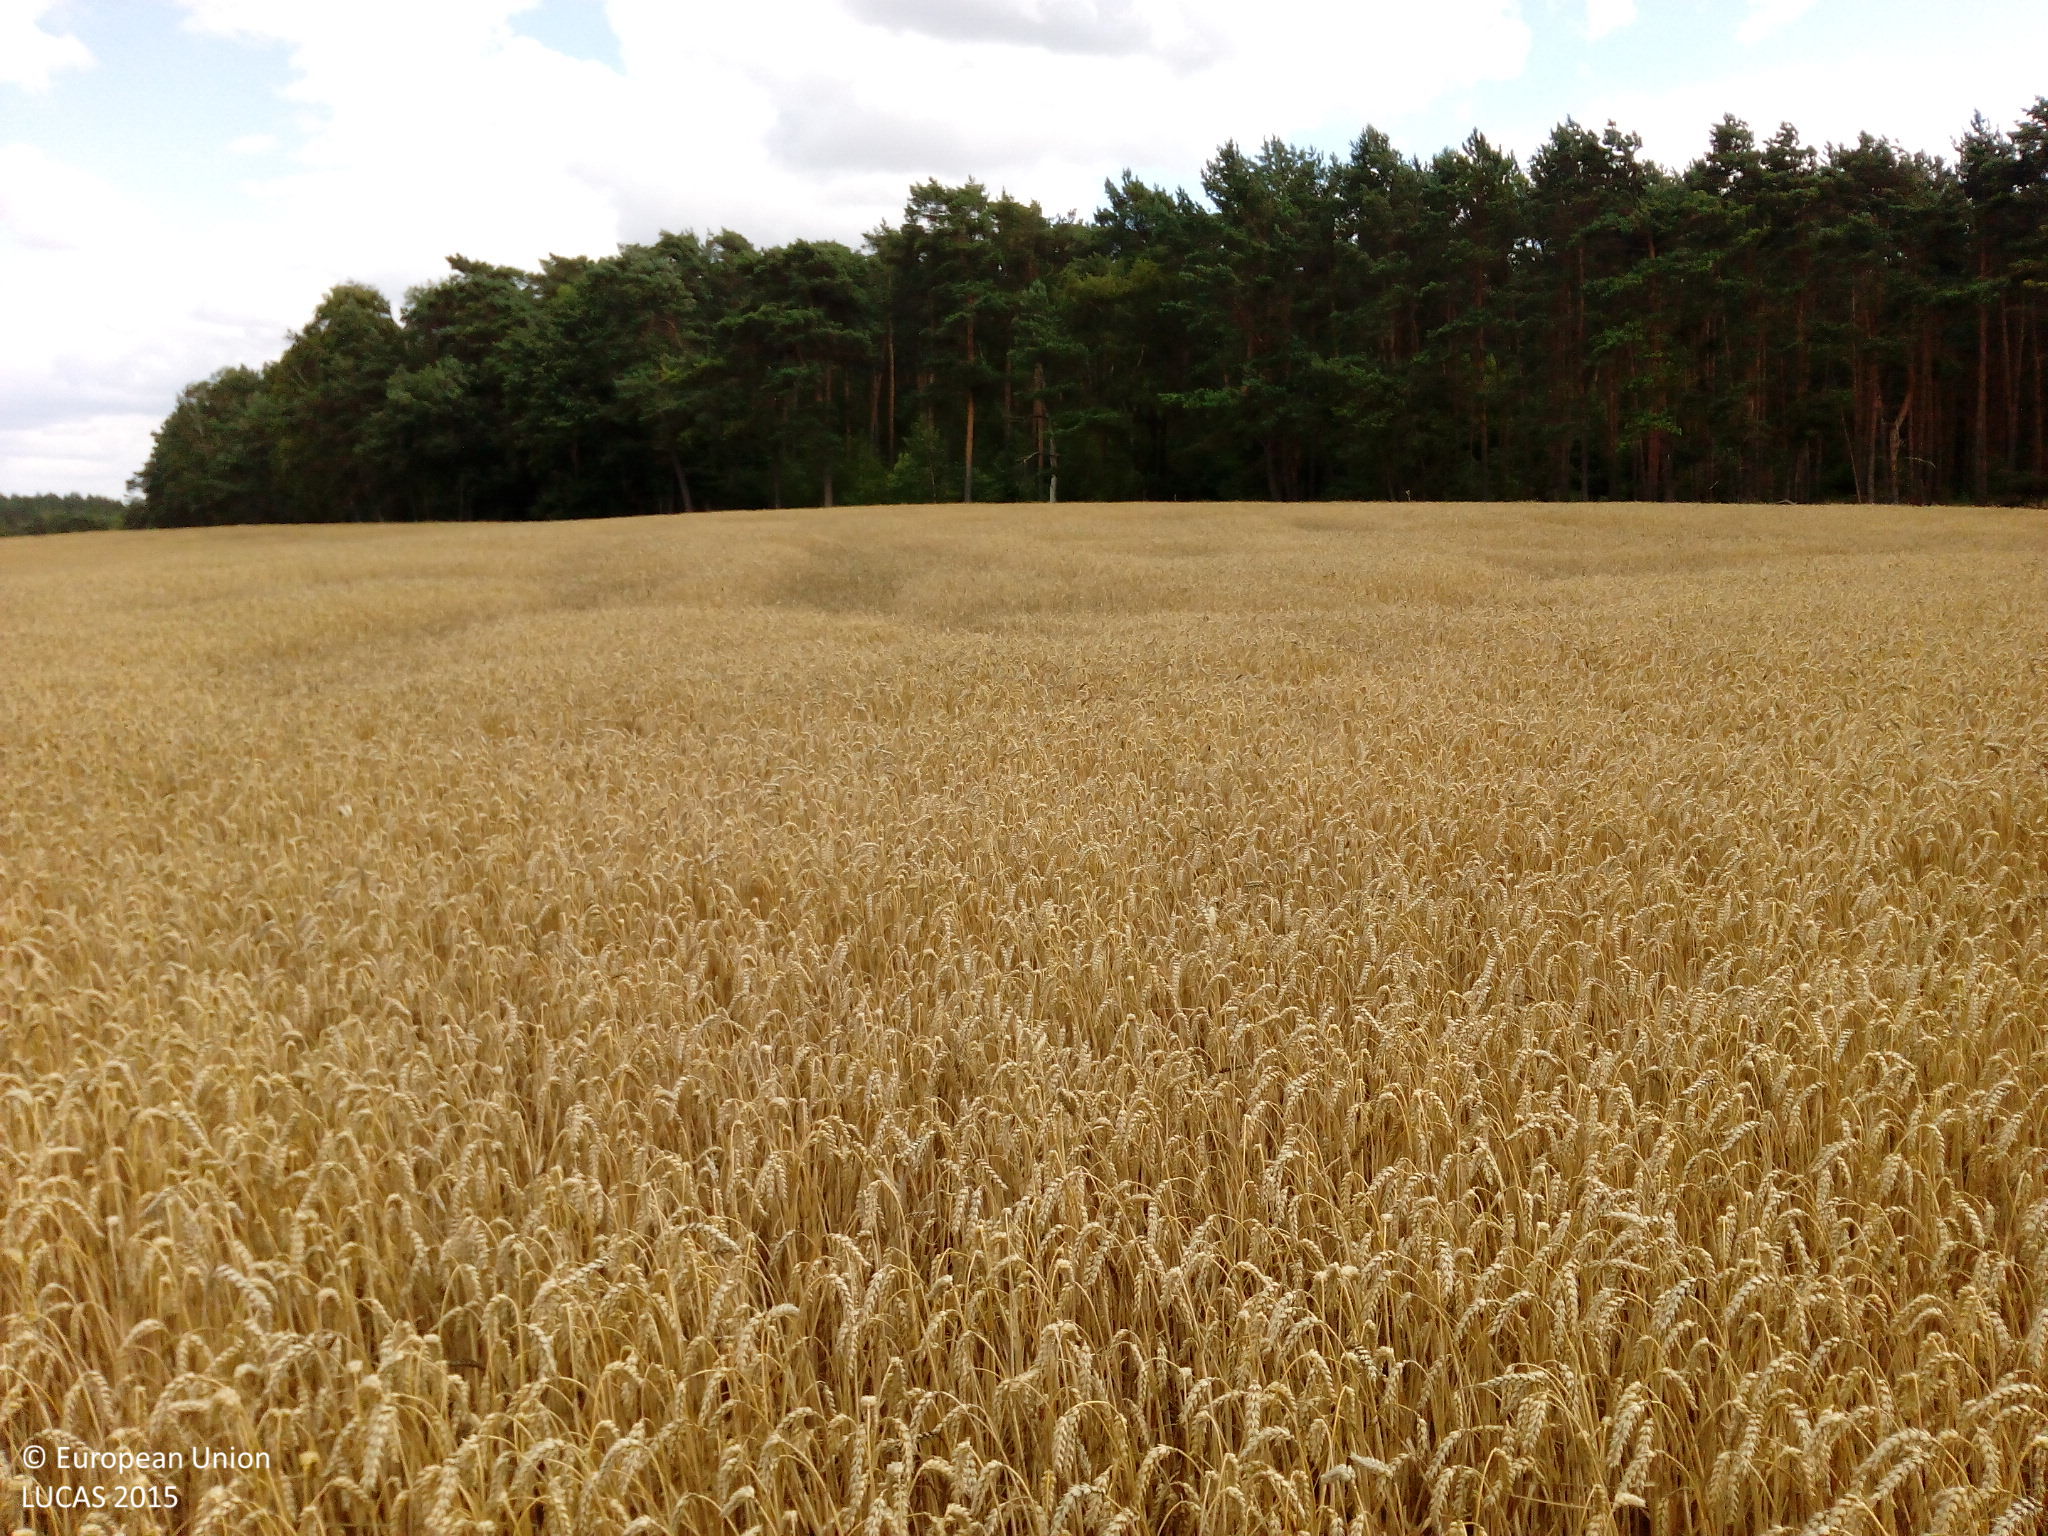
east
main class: Cropland
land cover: Common wheat
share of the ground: > 75 %
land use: Agriculture (excluding fallow land and kitchen gardens)
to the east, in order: Common wheat; Tracks; Fences; Pine dominated mixed woodland
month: July
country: DE
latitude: 52.6109
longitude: 14.1508
